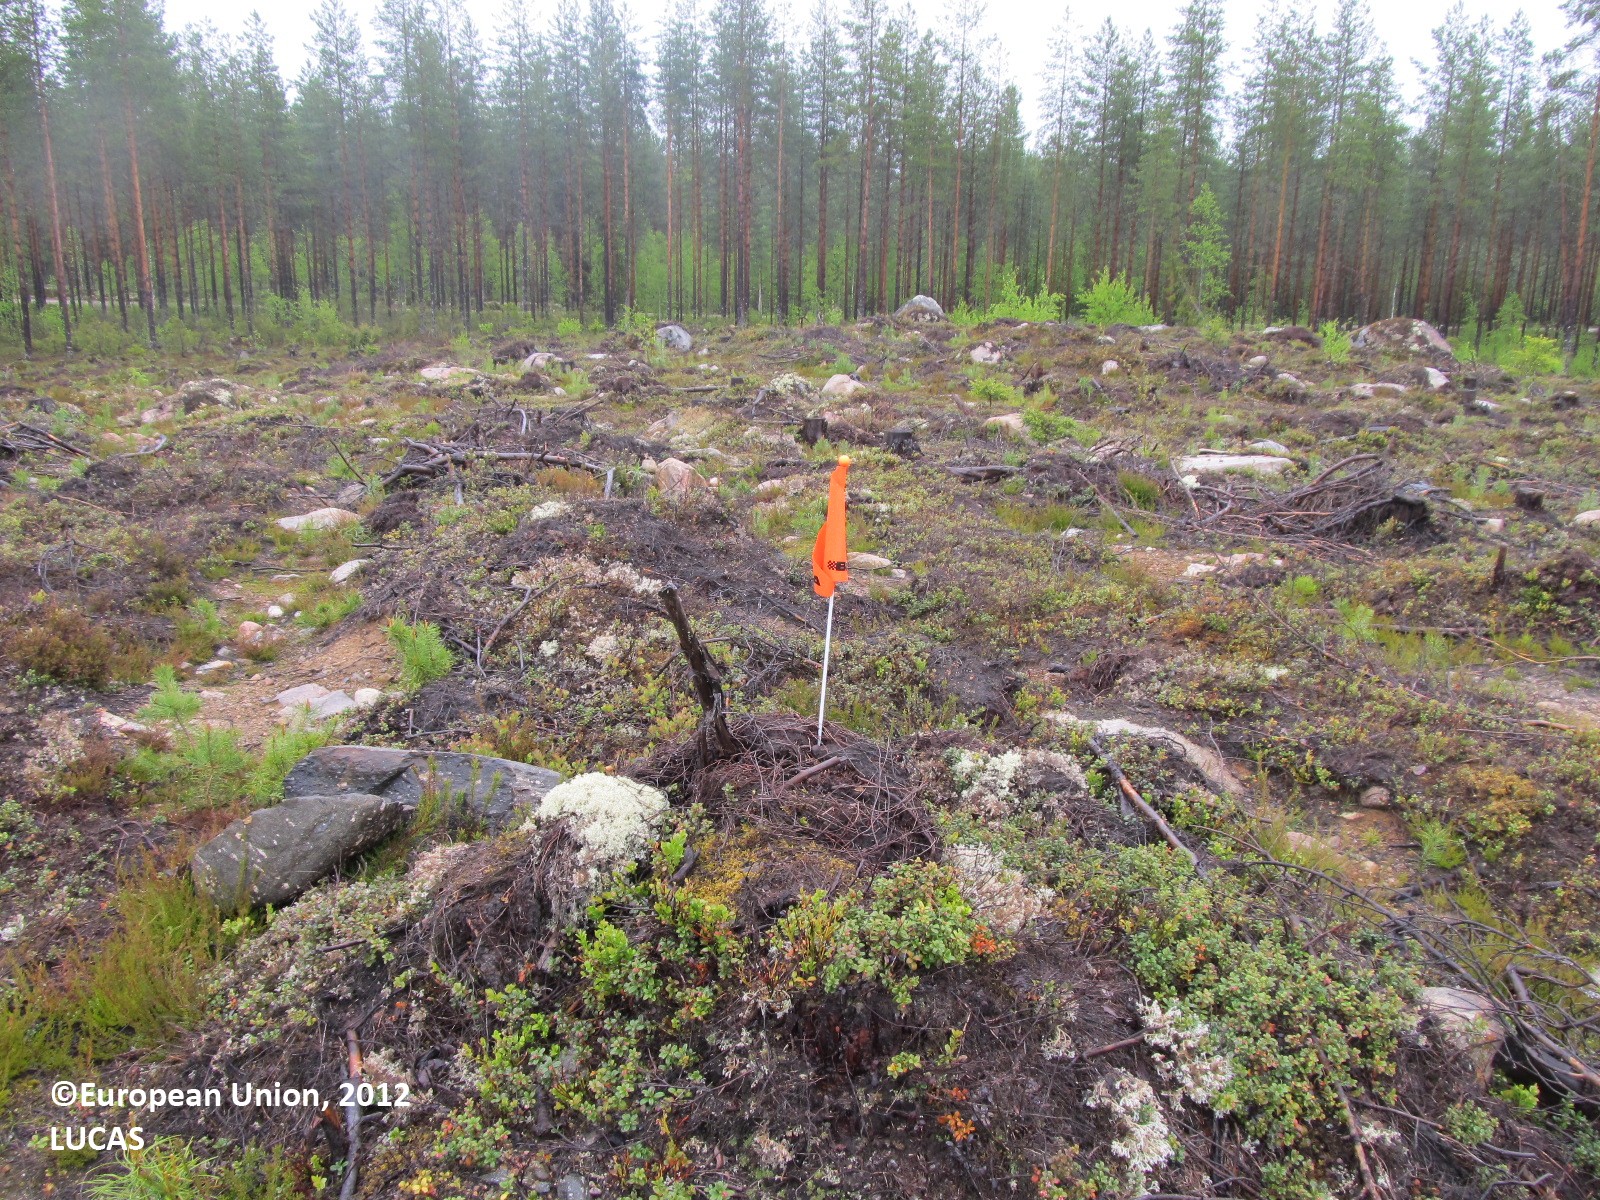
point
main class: Shrubland
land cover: Shrubland without tree cover
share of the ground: 50 - 75 %
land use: Forestry
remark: Clear cut
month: June
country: FI
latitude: 63.3061
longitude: 29.1511
